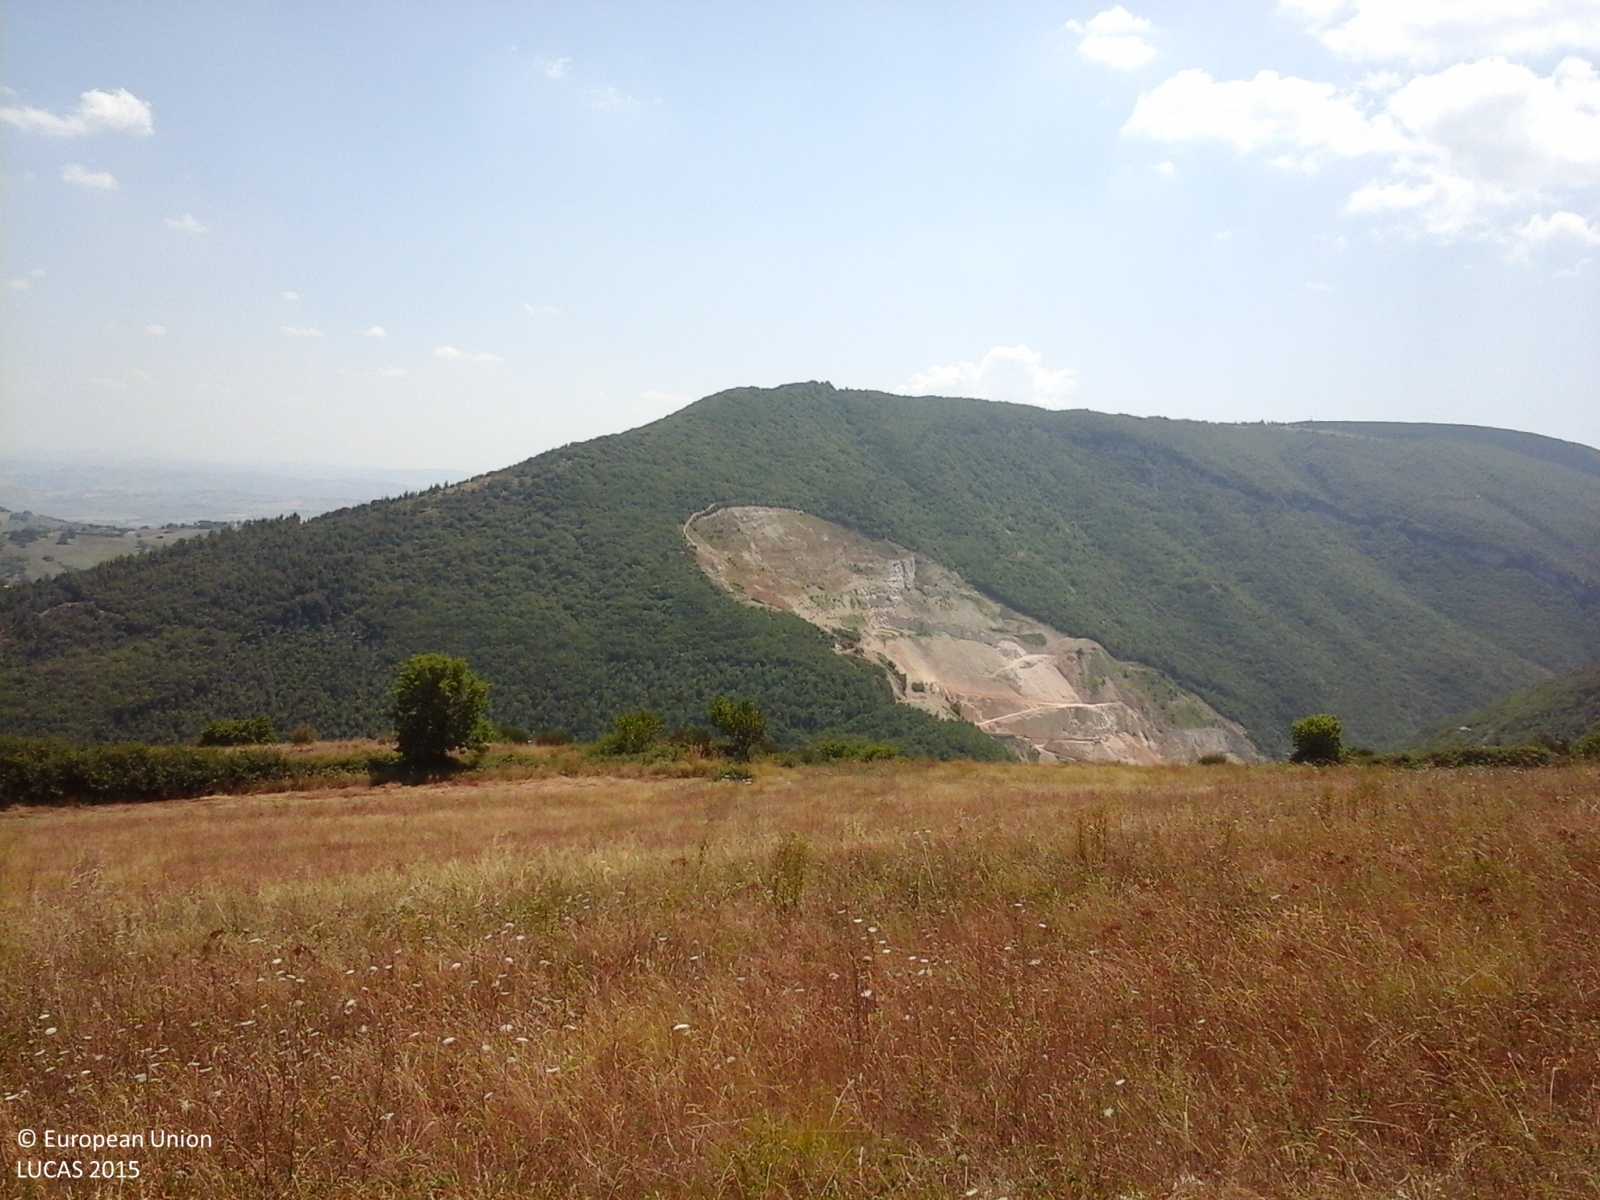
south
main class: Grassland
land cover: Grassland without tree/shrub cover
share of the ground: > 75 %
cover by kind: herbaceous plants 95 %, shrubs 5 %
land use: Agriculture (excluding fallow land and kitchen gardens)
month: August
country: IT
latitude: 43.3432
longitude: 13.2359
